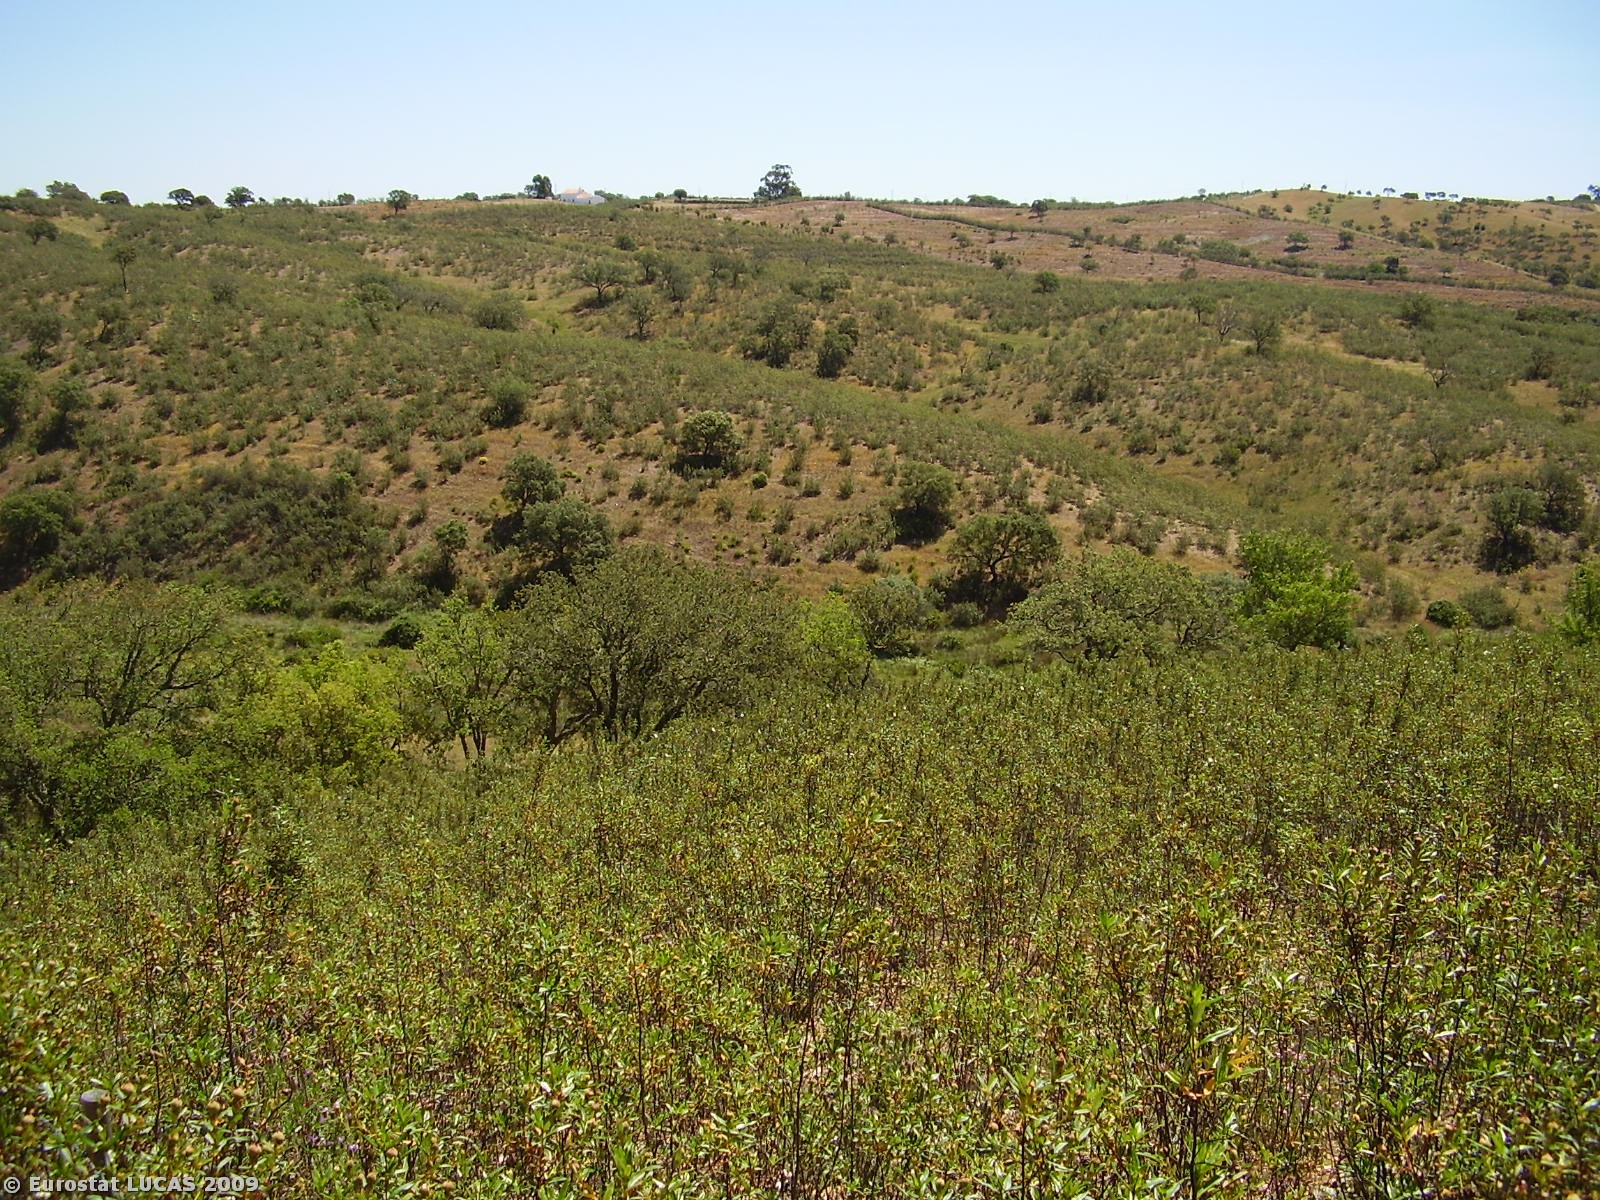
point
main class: Shrubland
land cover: Shrubland with sparse tree cover
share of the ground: > 75 %
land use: Fallow land
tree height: > 5 m
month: May
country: PT
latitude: 37.4938
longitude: -8.2011
